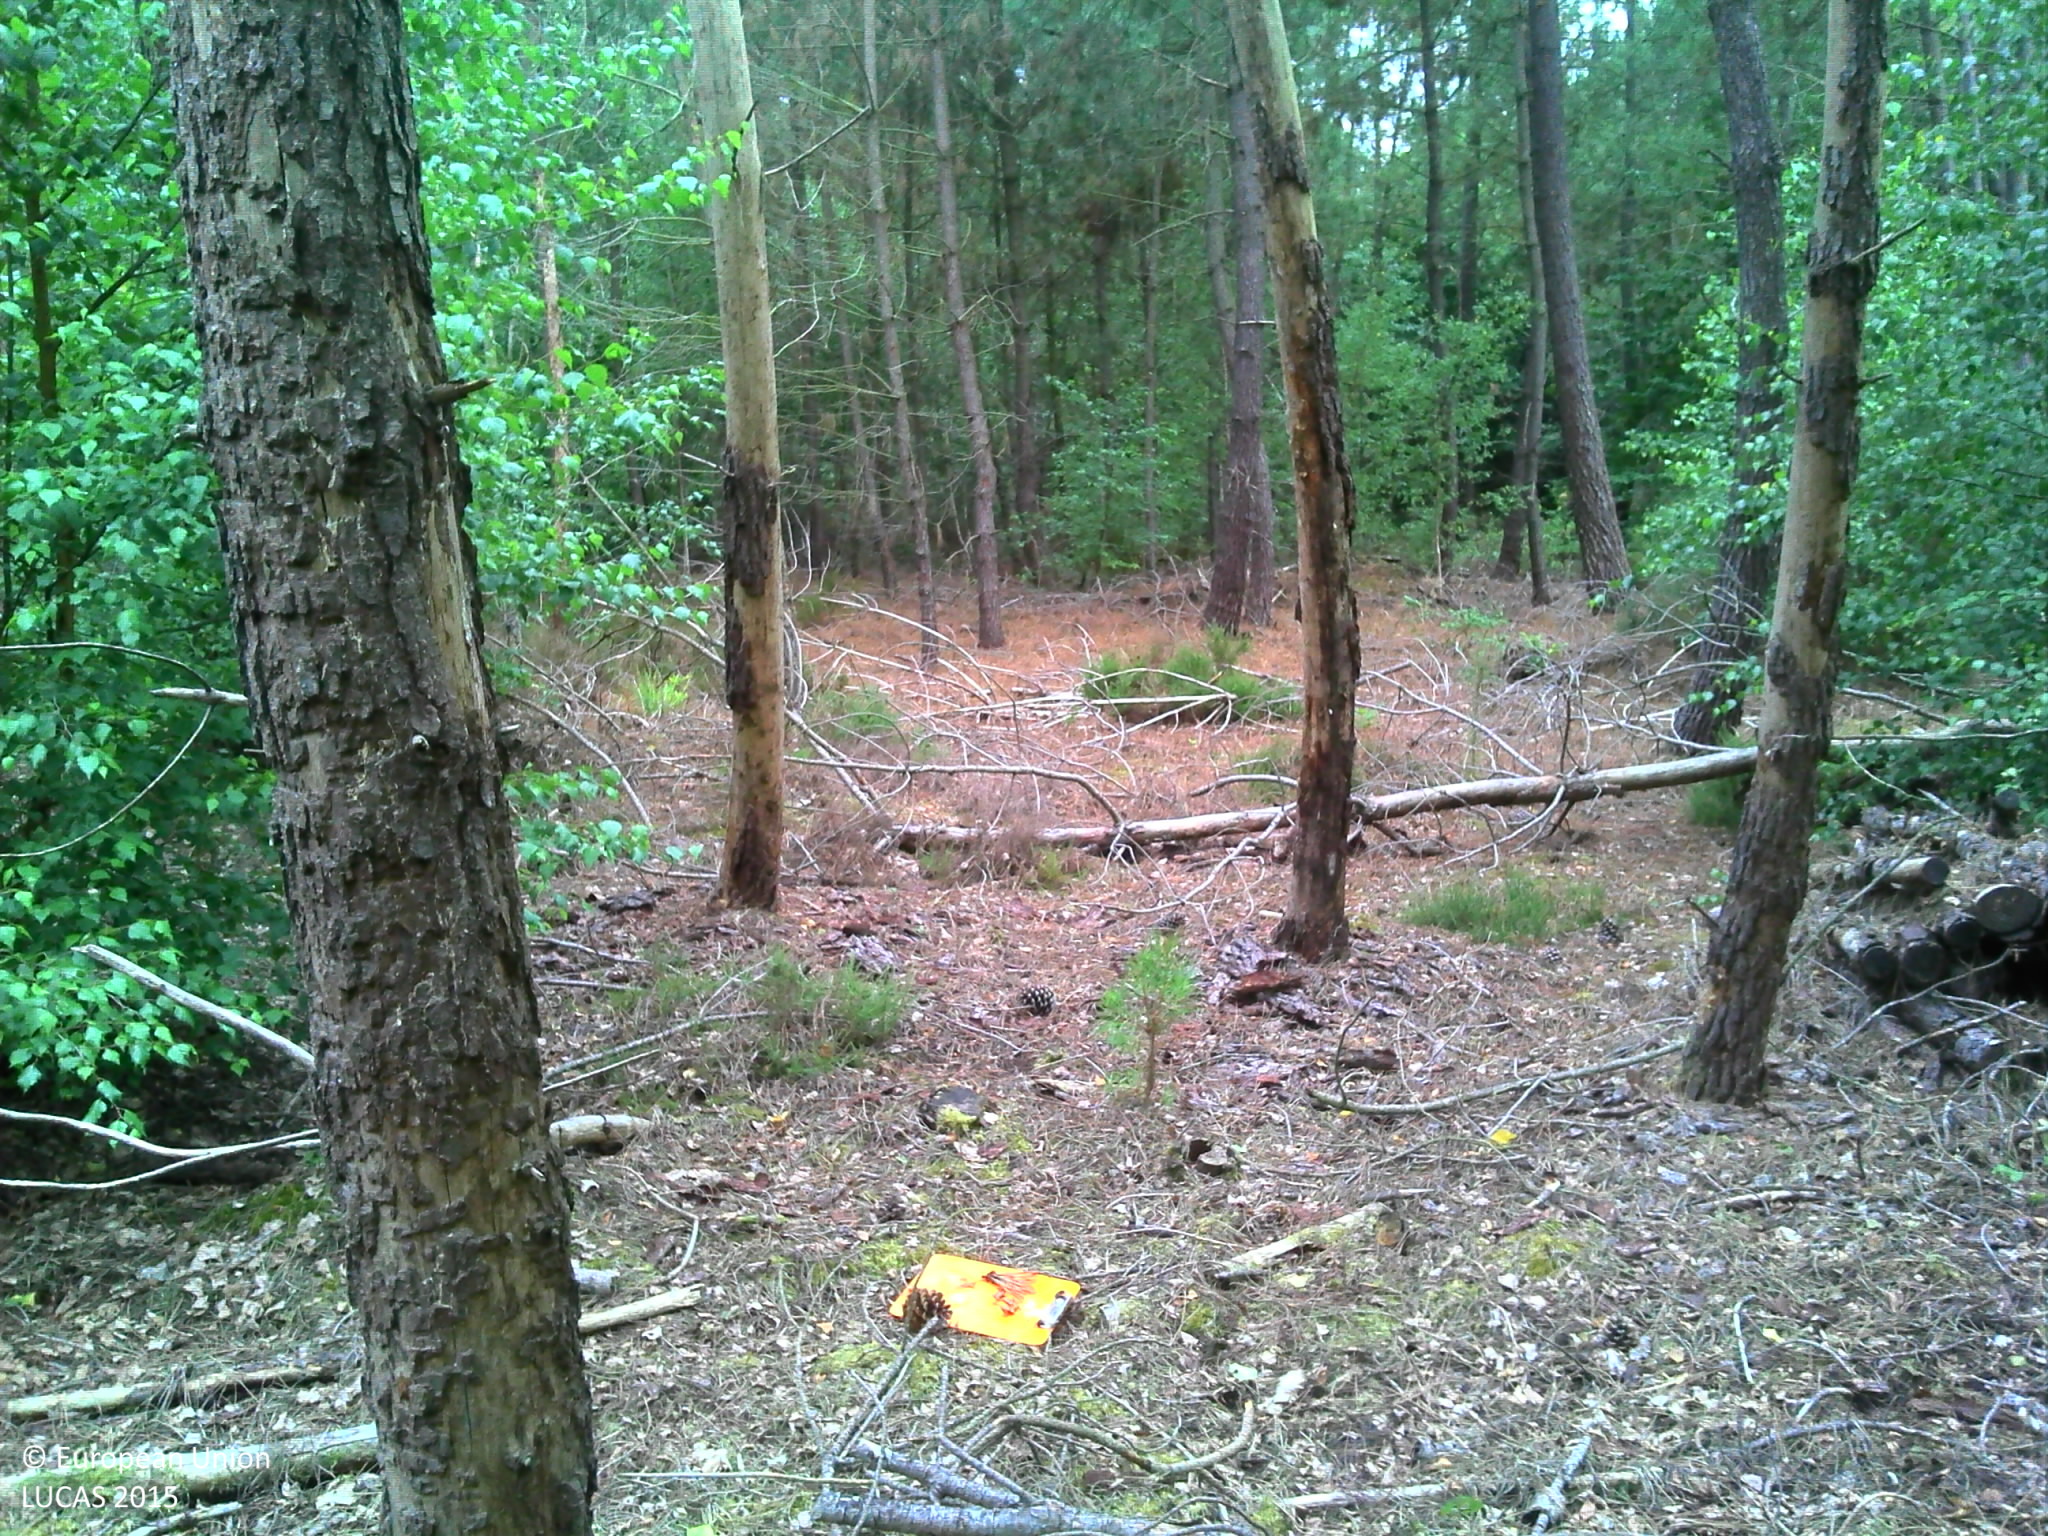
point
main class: Woodland
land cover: Pine dominated coniferous woodland
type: exotic forest
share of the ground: > 75 %
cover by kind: coniferous forest trees 60 %, herbaceous plants 30 %, shrubs 10 %
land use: Forestry
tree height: > 5 m
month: July
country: FR
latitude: 47.8884
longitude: 0.3331
